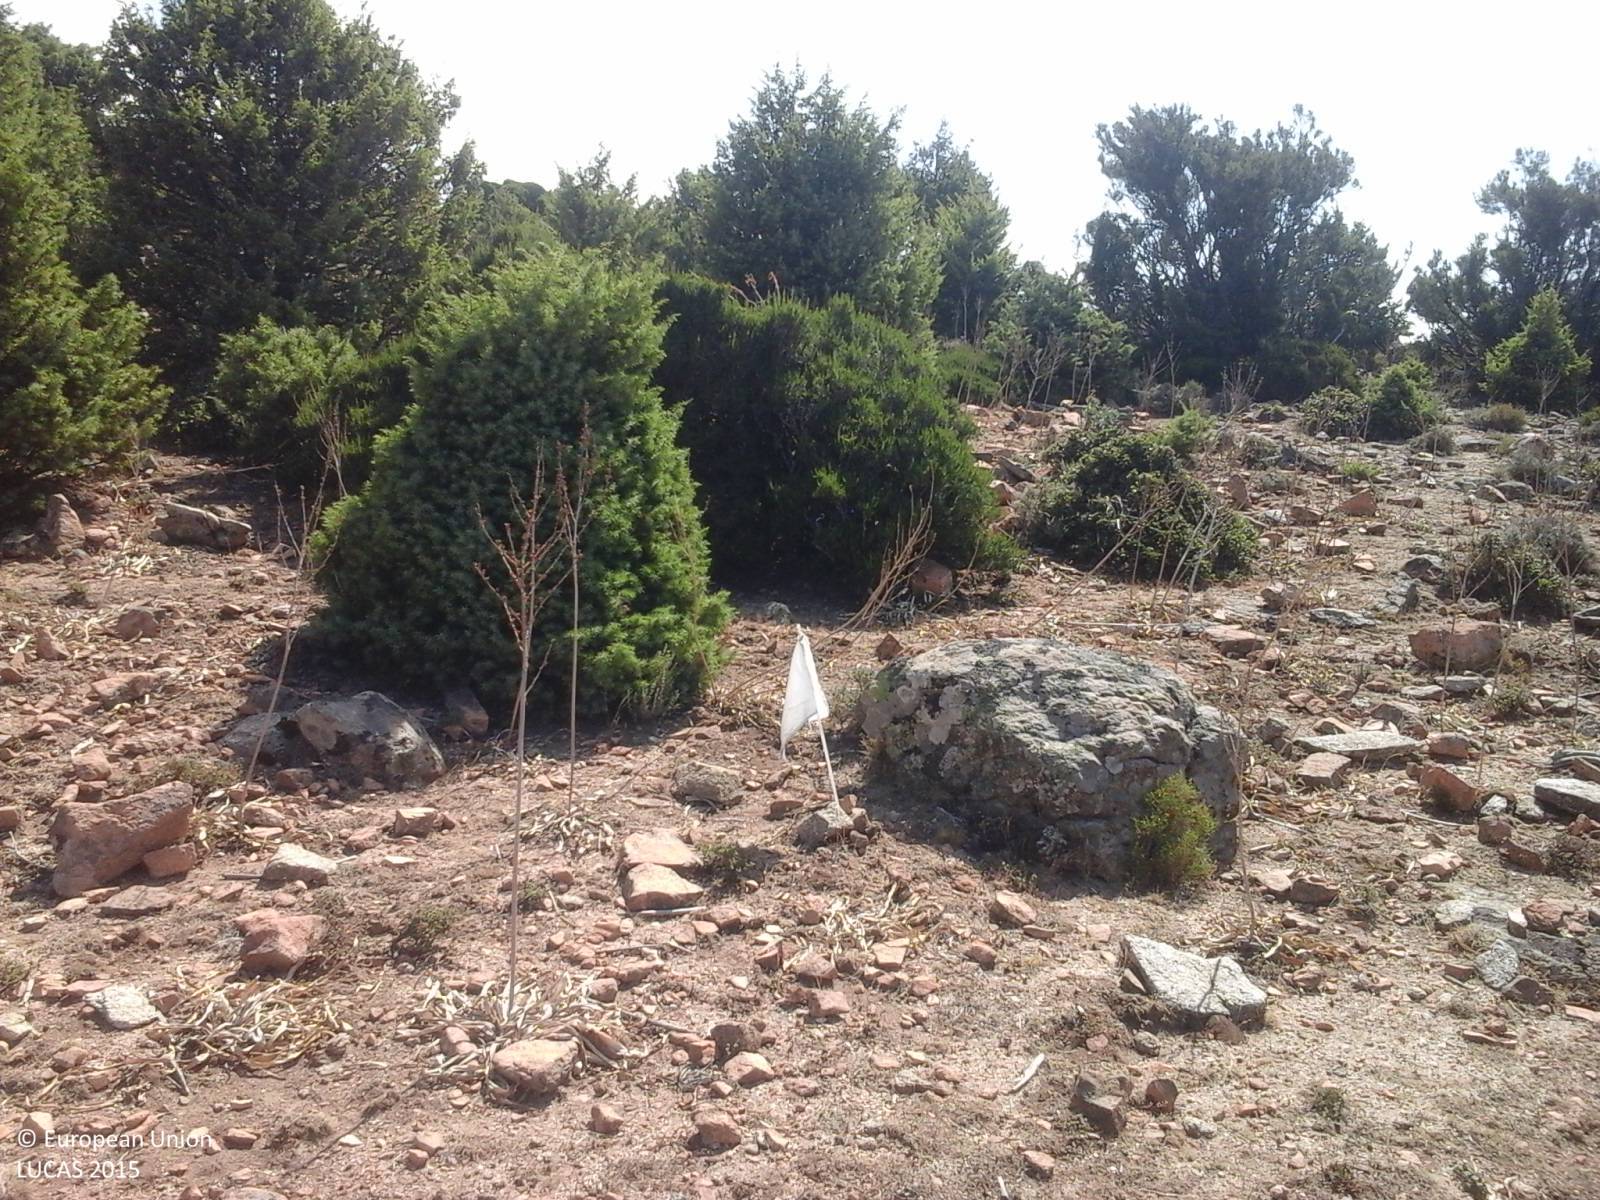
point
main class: Shrubland
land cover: Shrubland with sparse tree cover
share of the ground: > 75 %
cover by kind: shrubs 45 %, consolidated bare surface 25 %, unconsolidated bare surface 20 %, coniferous forest trees 5 %, herbaceous plants 5 %
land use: Agriculture (excluding fallow land and kitchen gardens)
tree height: > 5 m
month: September
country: IT
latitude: 40.0122
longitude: 9.4291
